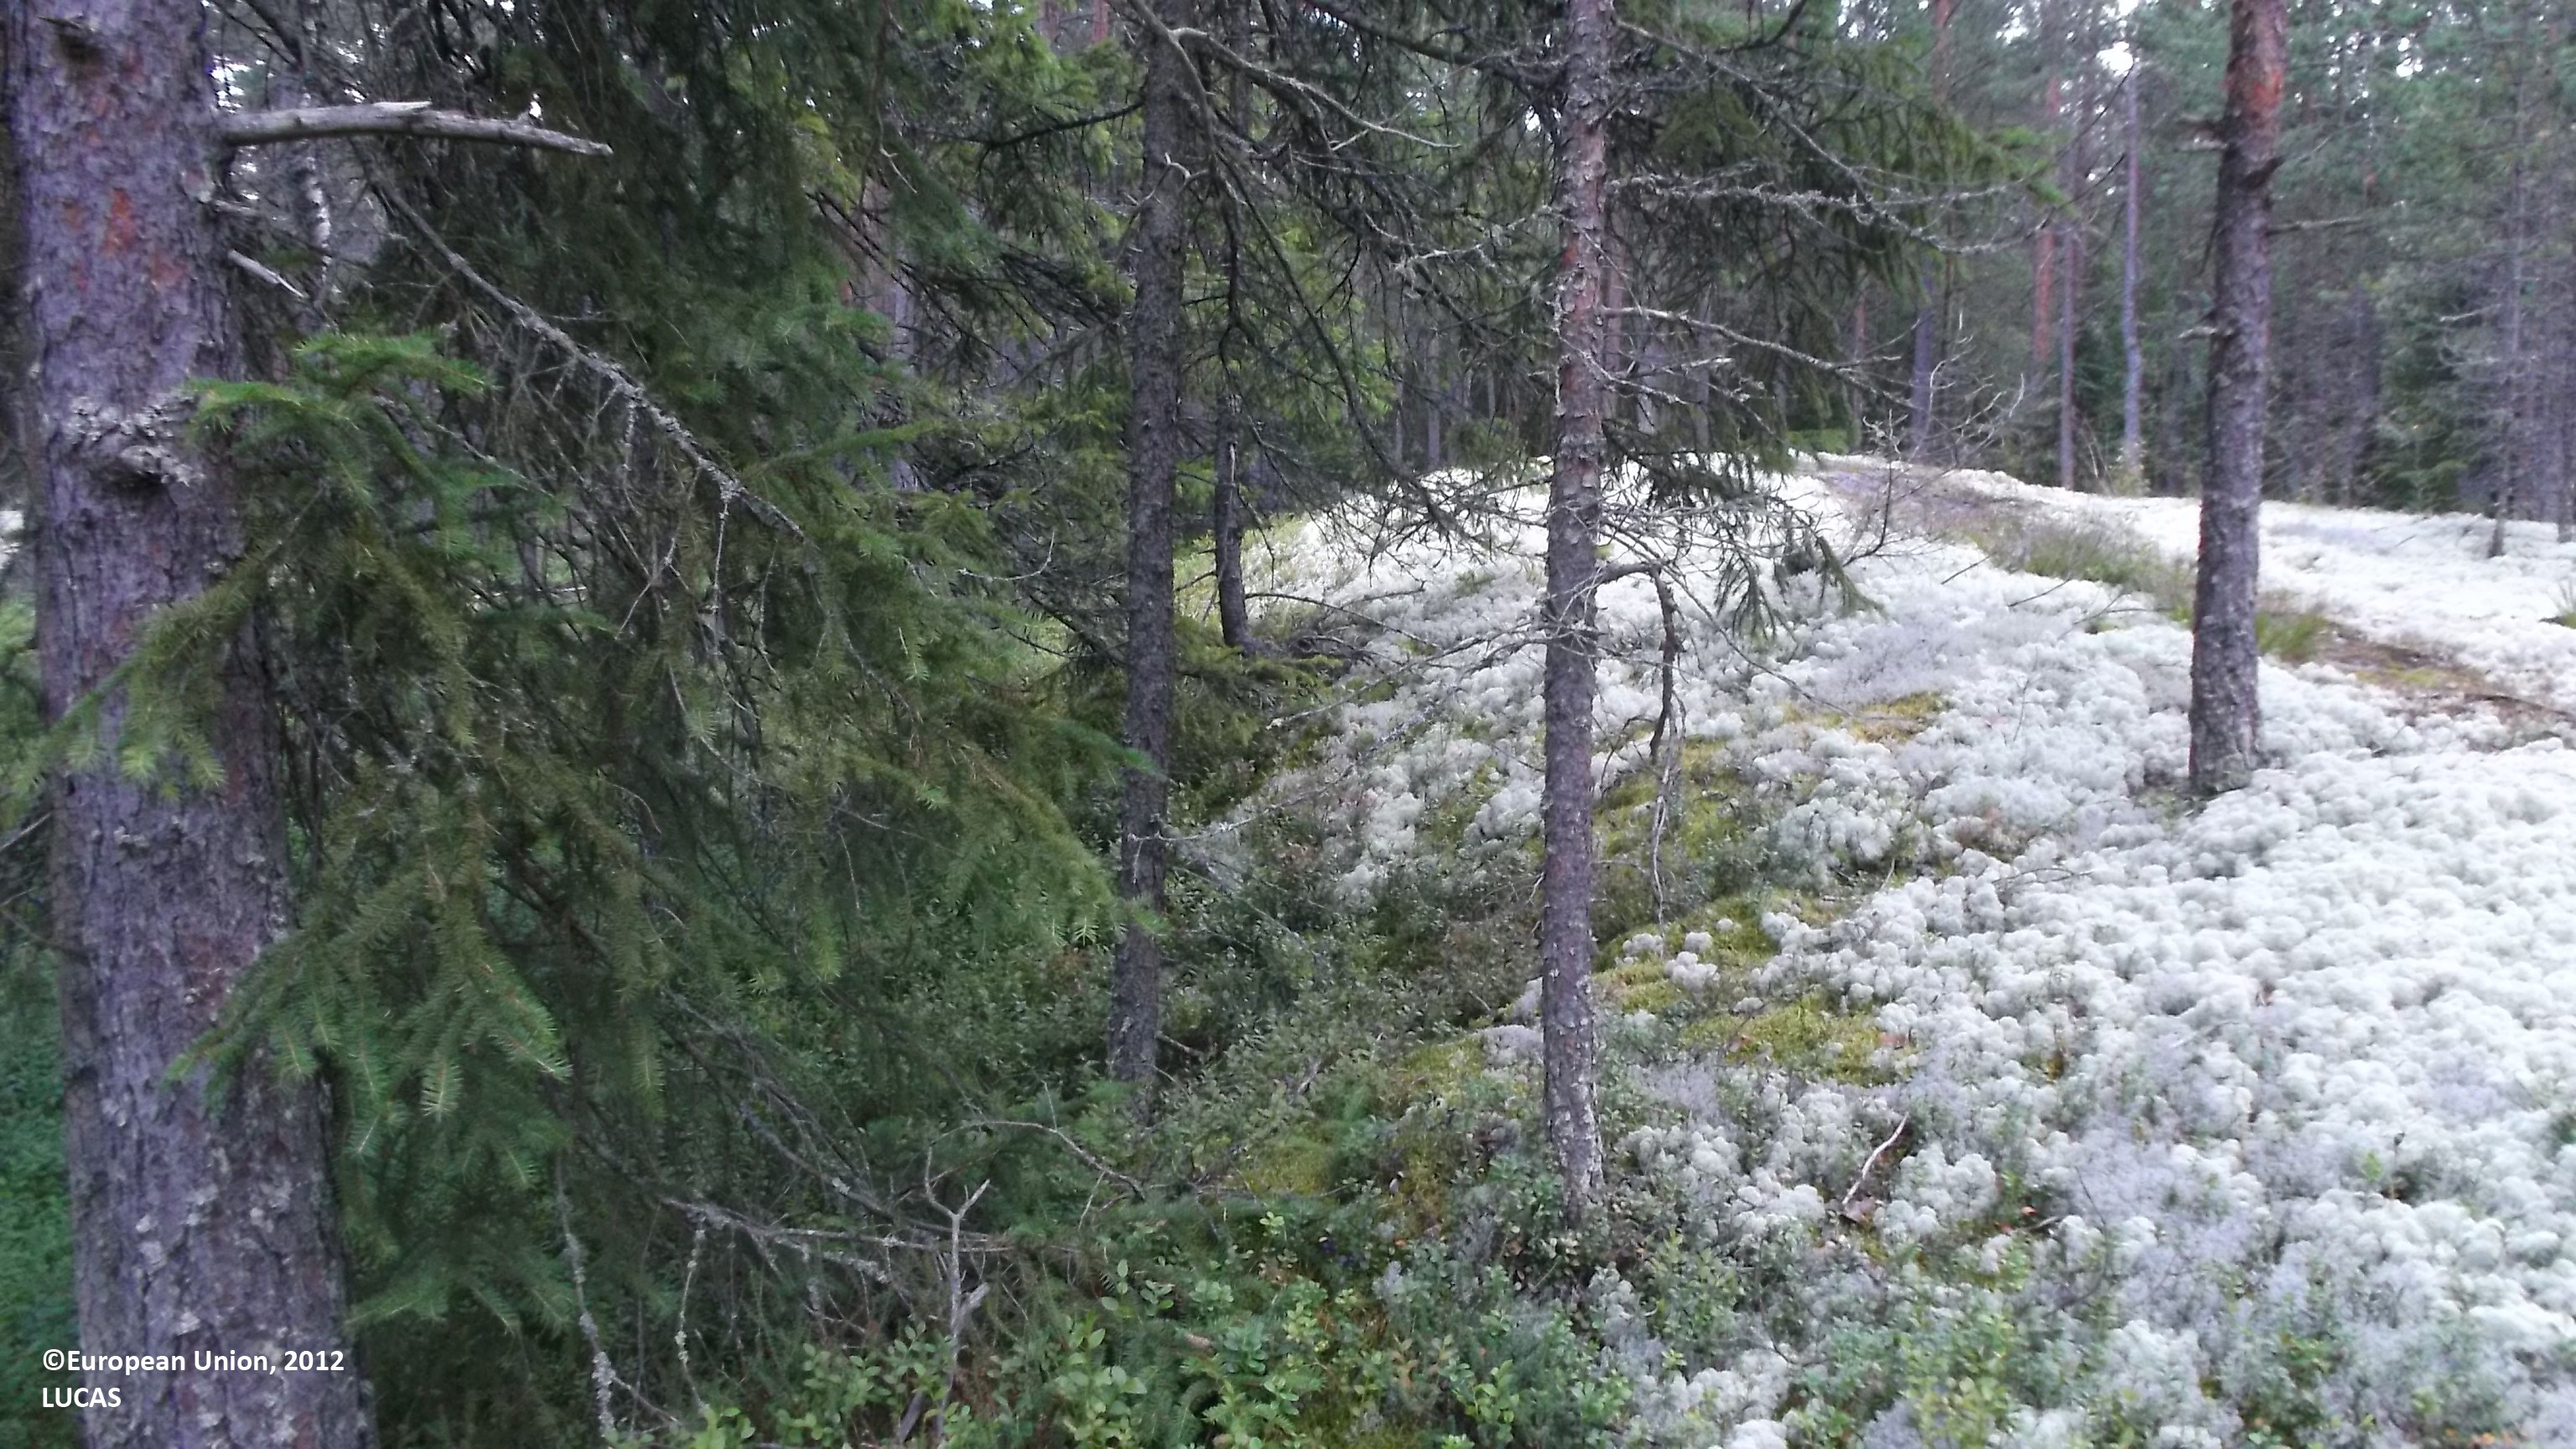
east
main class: Woodland
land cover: Pine dominated mixed woodland
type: boreal forest
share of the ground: 25 - 50 %
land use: Forestry
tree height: > 5 m
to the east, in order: Pine dominated mixed woodland; Pine dominated coniferous woodland; Pine dominated mixed woodland; Other mixed woodland; Pine dominated mixed woodland; Other mixed woodland
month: August
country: FI
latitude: 64.0168
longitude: 23.5393
